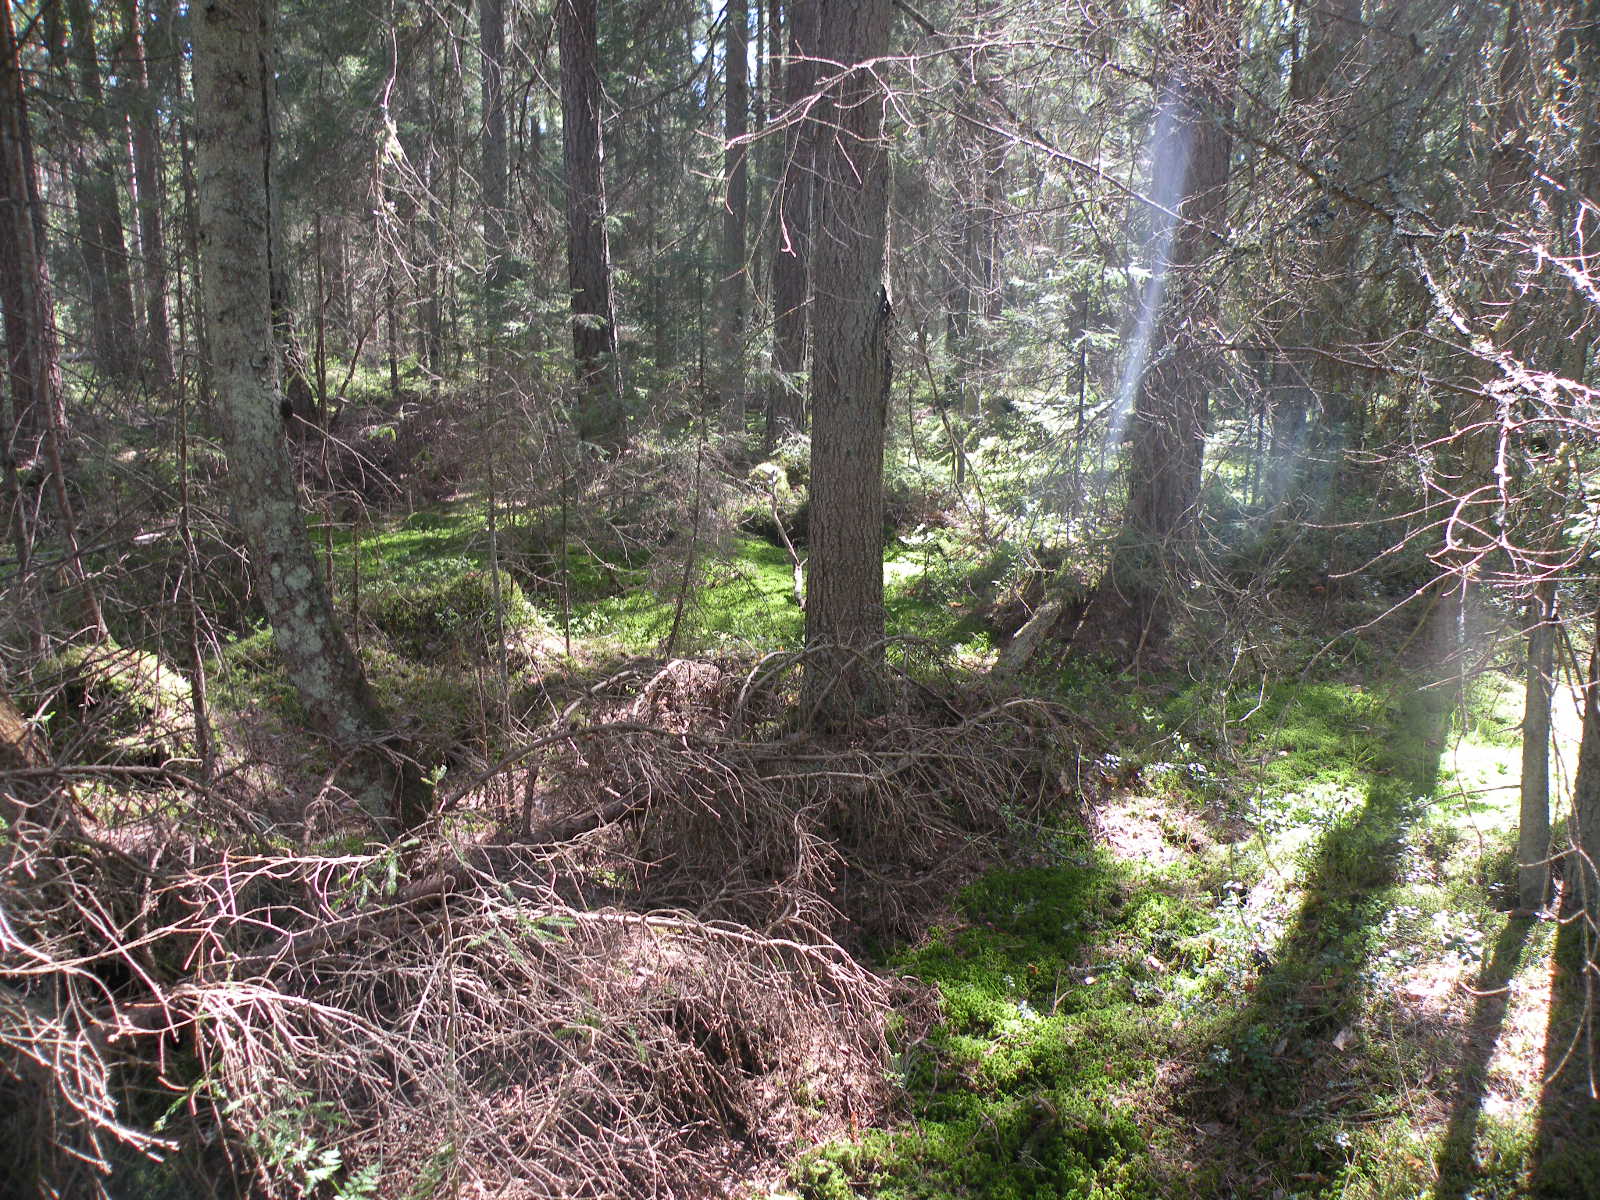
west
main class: Woodland
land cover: Spruce dominated coniferous woodland
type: hemiboreal forest and nemoral coniferous forest and mixed broadleaved-coniferous forest
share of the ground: > 75 %
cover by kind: coniferous forest trees 100 %
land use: Forestry
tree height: > 5 m
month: May
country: LV
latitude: 56.0956
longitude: 26.2656
